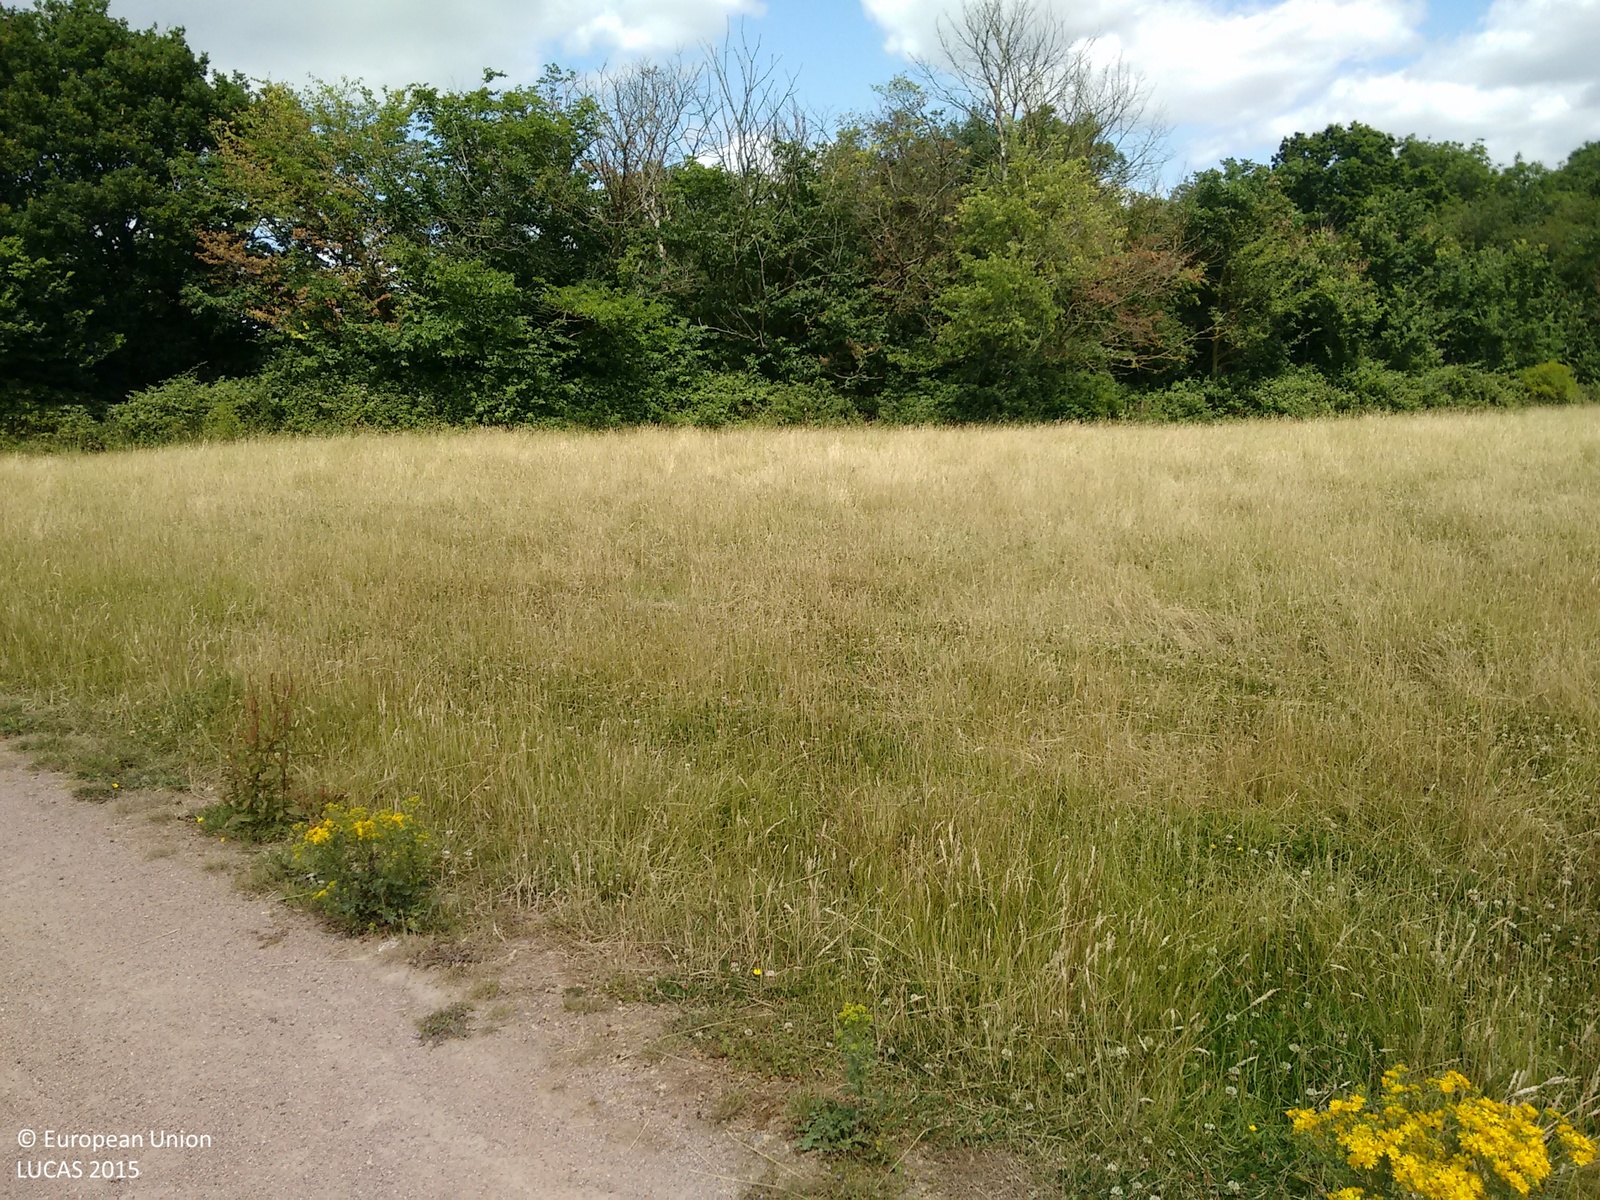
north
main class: Grassland
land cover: Grassland without tree/shrub cover
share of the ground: > 75 %
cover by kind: herbaceous plants 100 %
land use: Agriculture (excluding fallow land and kitchen gardens)
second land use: Amenities, museums, leisure
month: July
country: GB
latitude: 51.5846
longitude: 0.3443
